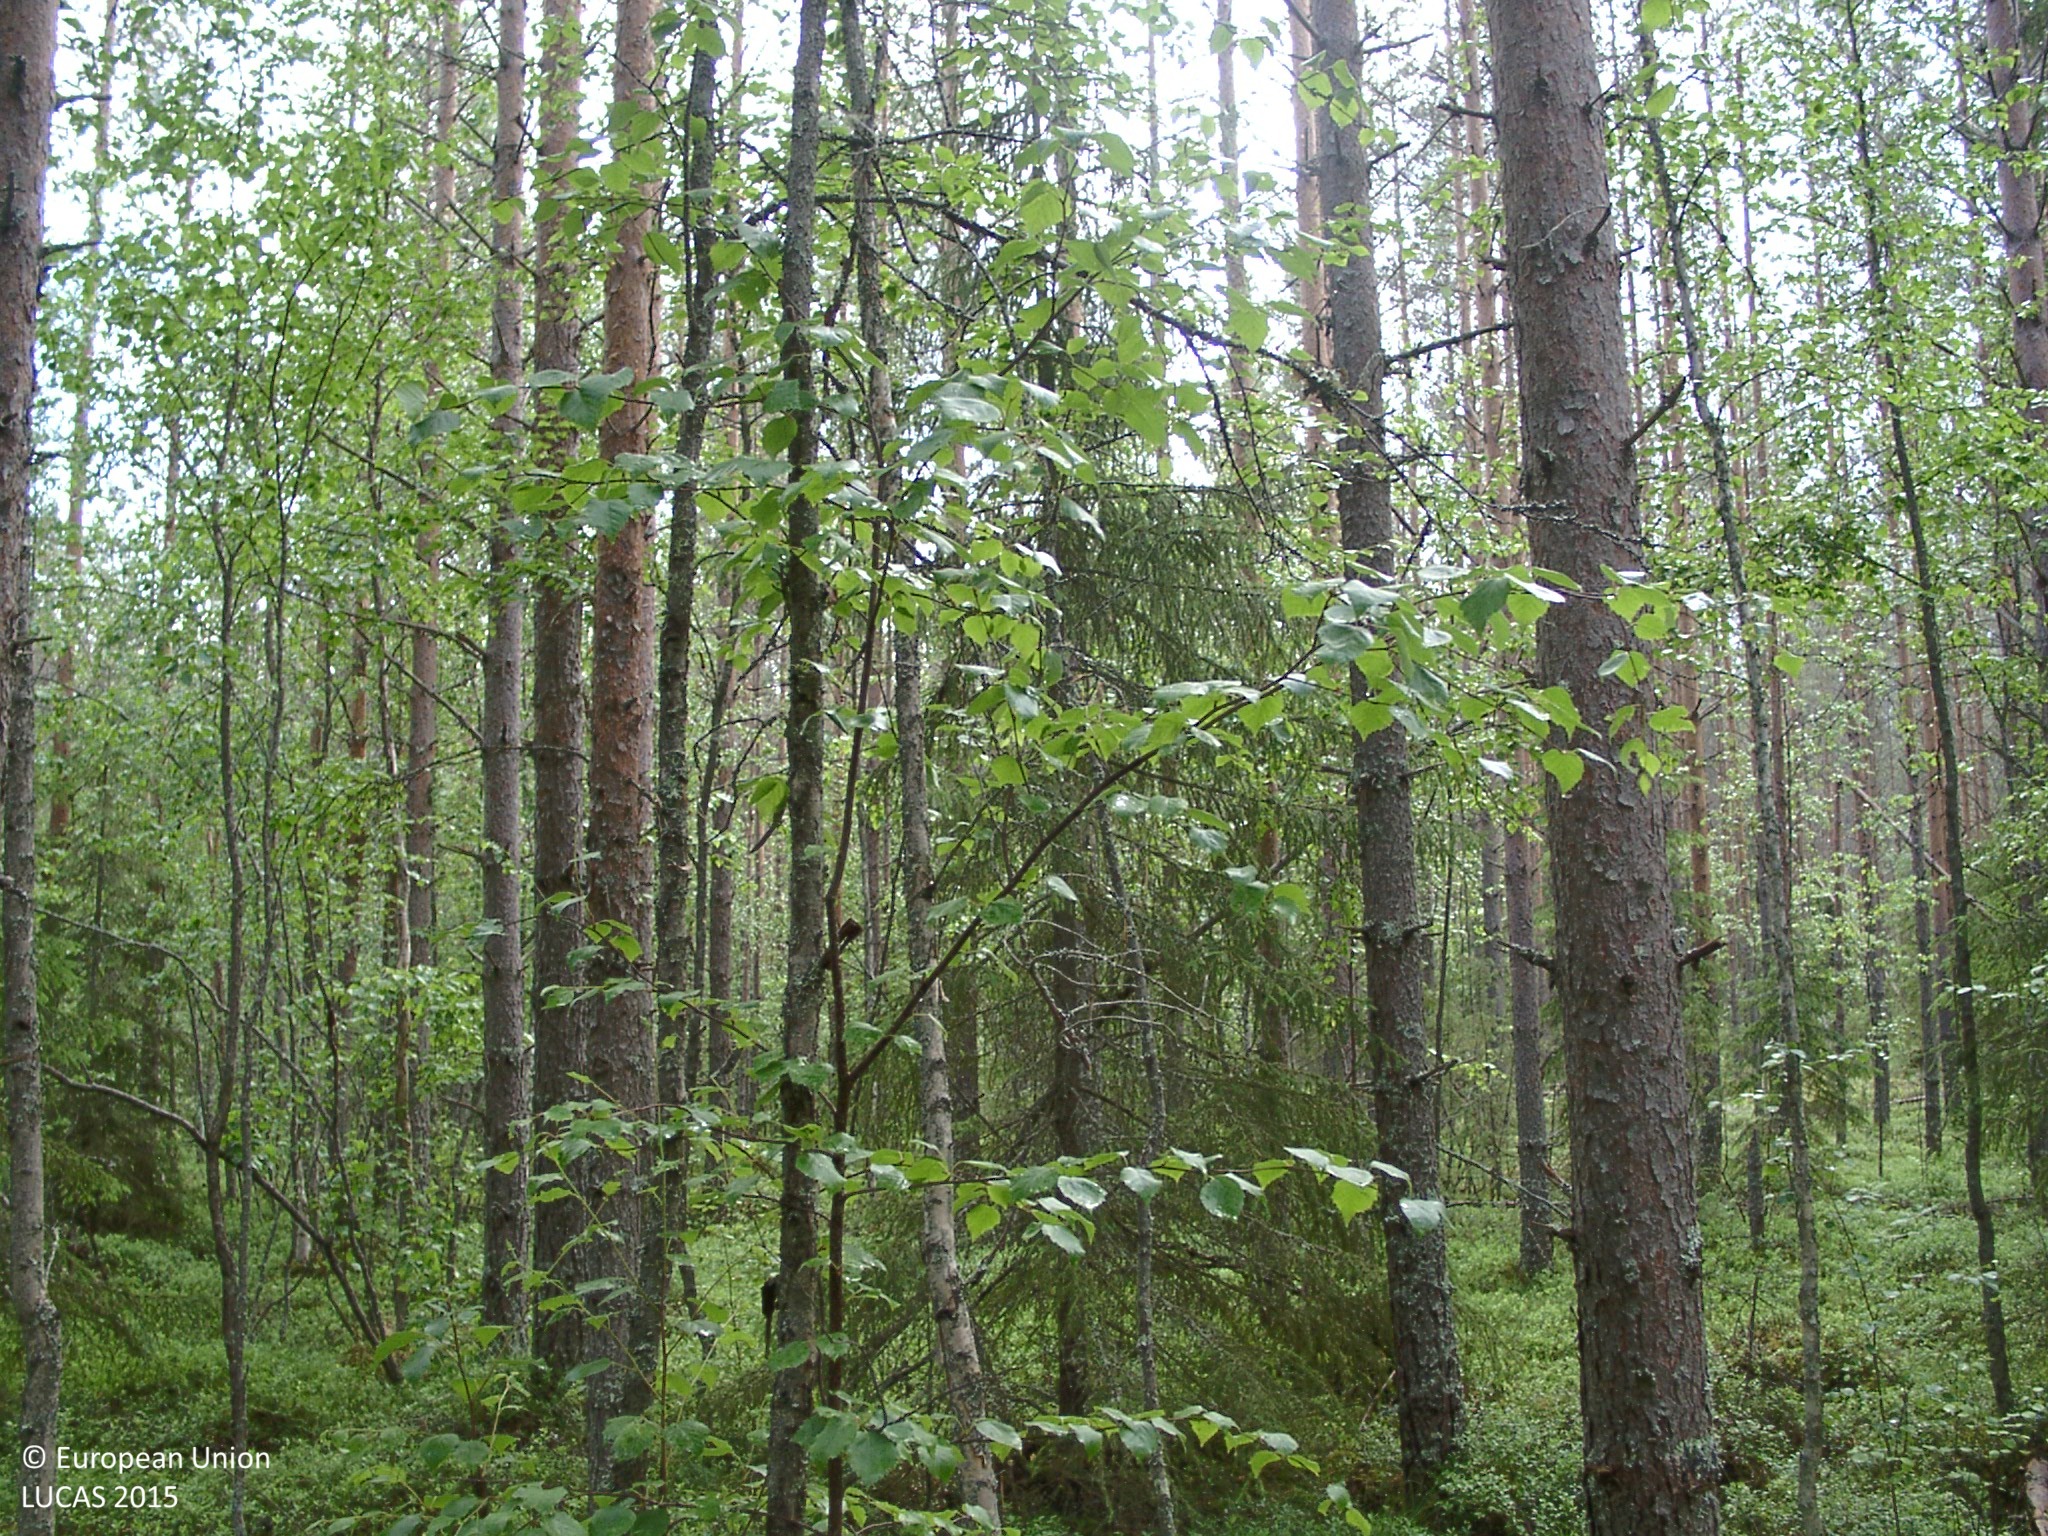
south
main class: Woodland
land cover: Other mixed woodland
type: boreal forest
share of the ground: 50 - 75 %
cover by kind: coniferous forest trees 55 %, broadleaved forest trees 20 %, shrubs 20 %, lichens and mosses 5 %
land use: Semi-natural and natural areas not in use
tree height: > 5 m
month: July
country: FI
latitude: 62.1580
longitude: 25.0955
